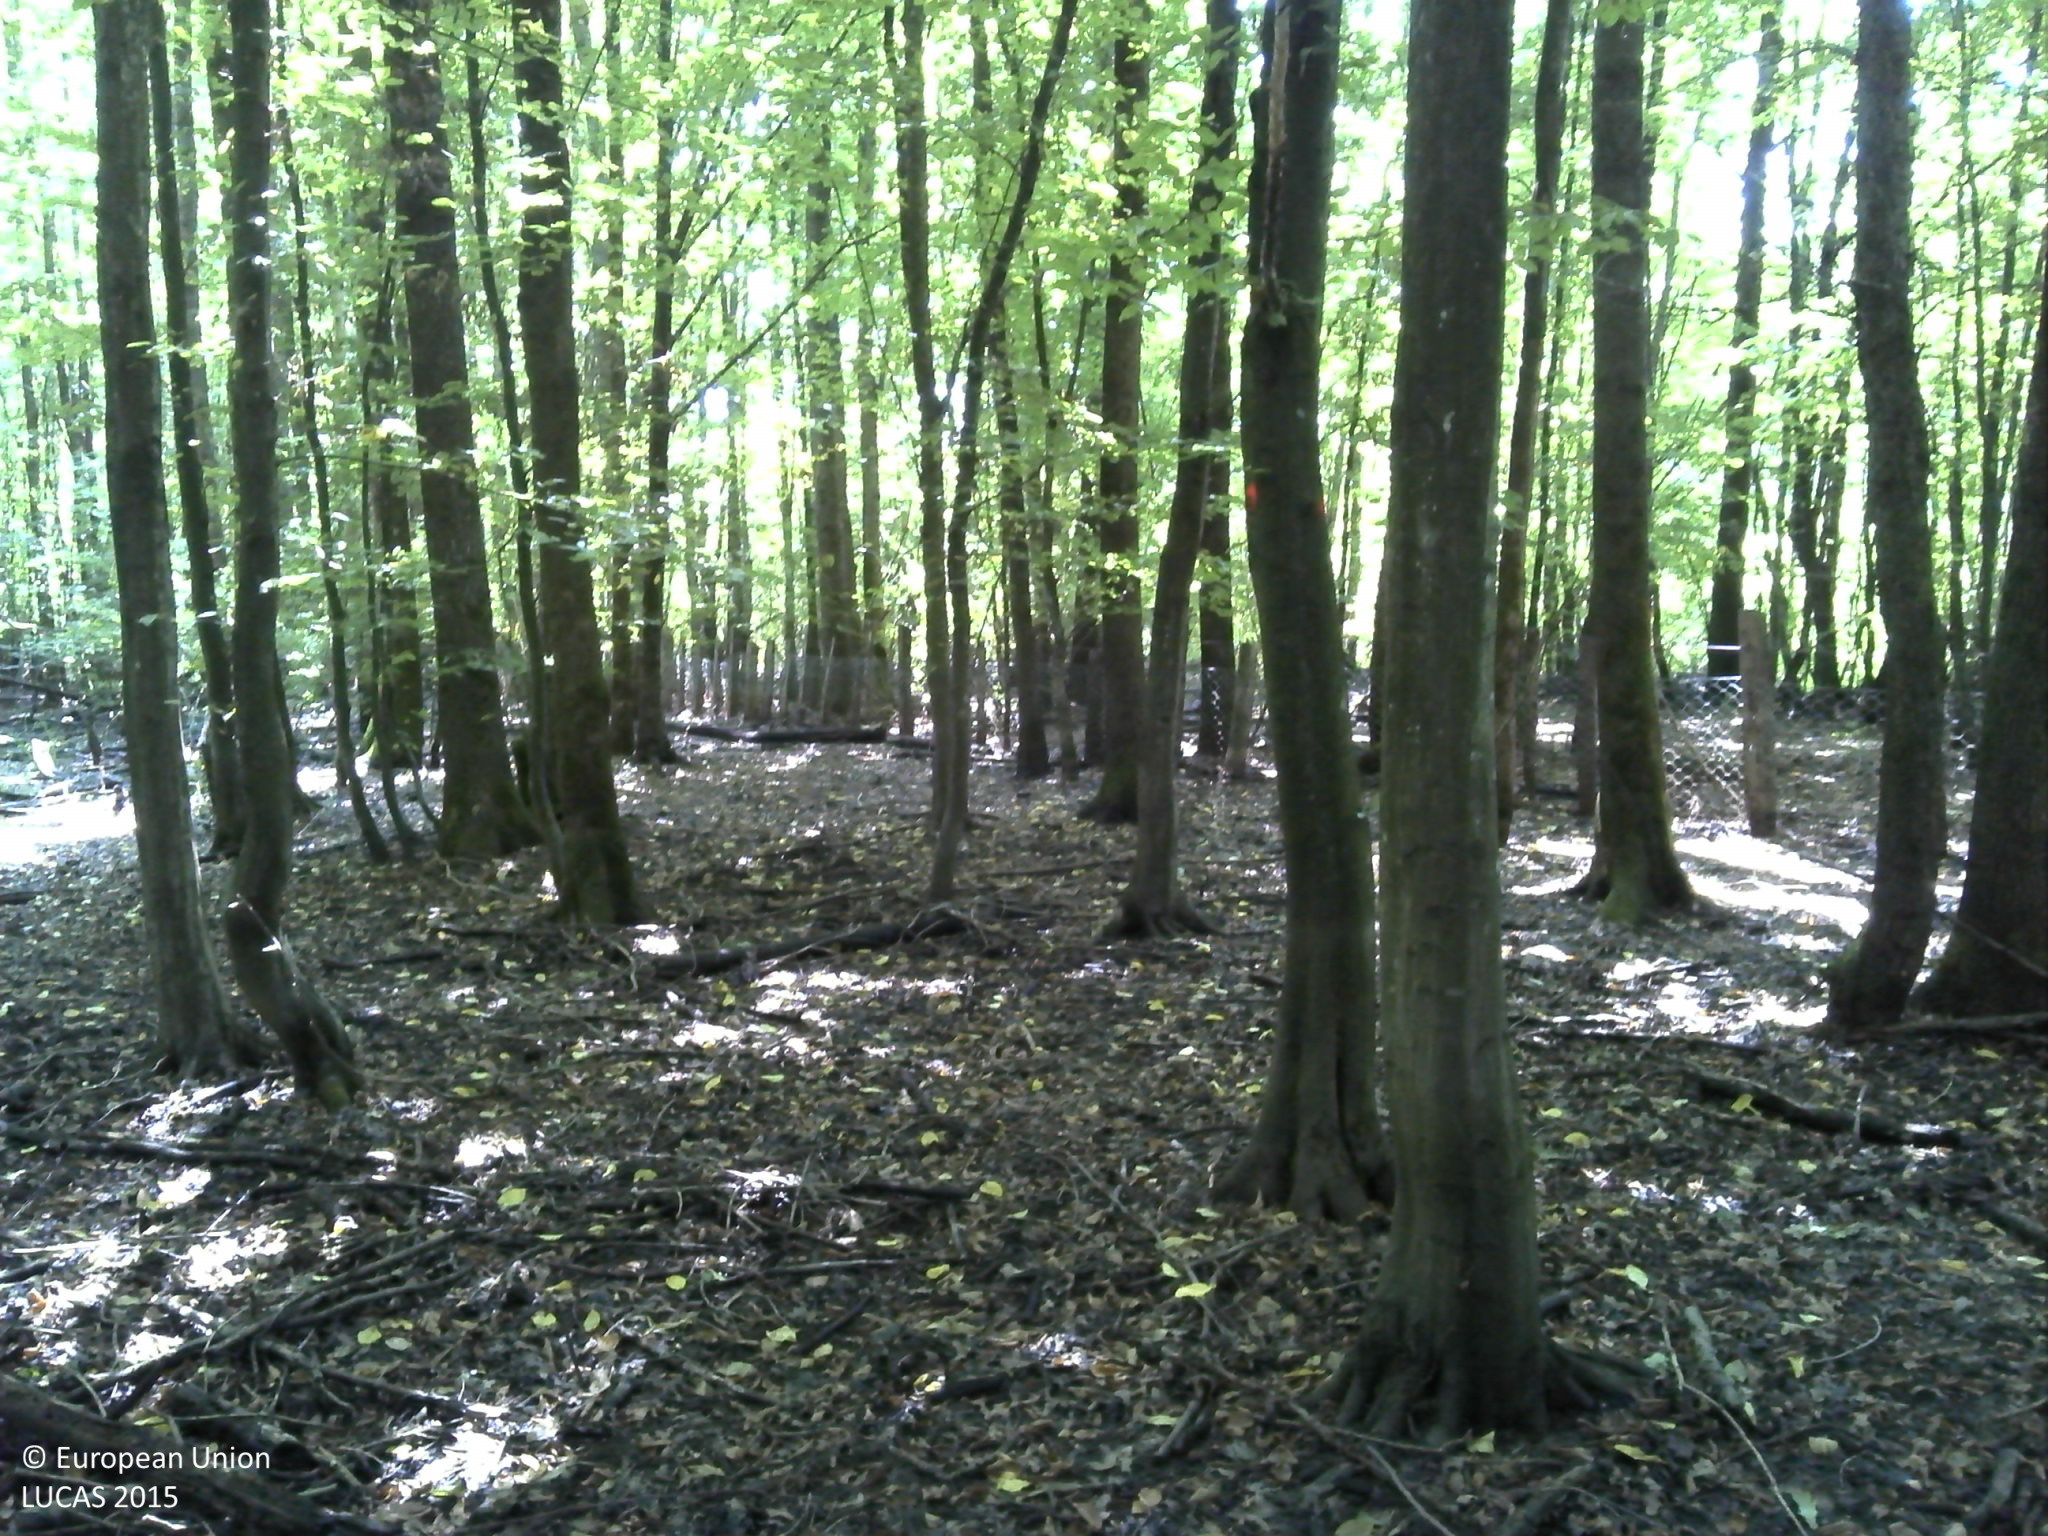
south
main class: Woodland
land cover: Broadleaved woodland
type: acidophilous oak and oak-birch forest
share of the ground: > 75 %
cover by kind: broadleaved forest trees 100 %
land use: Forestry
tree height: > 5 m
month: August
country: HR
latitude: 45.5185
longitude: 16.5401
